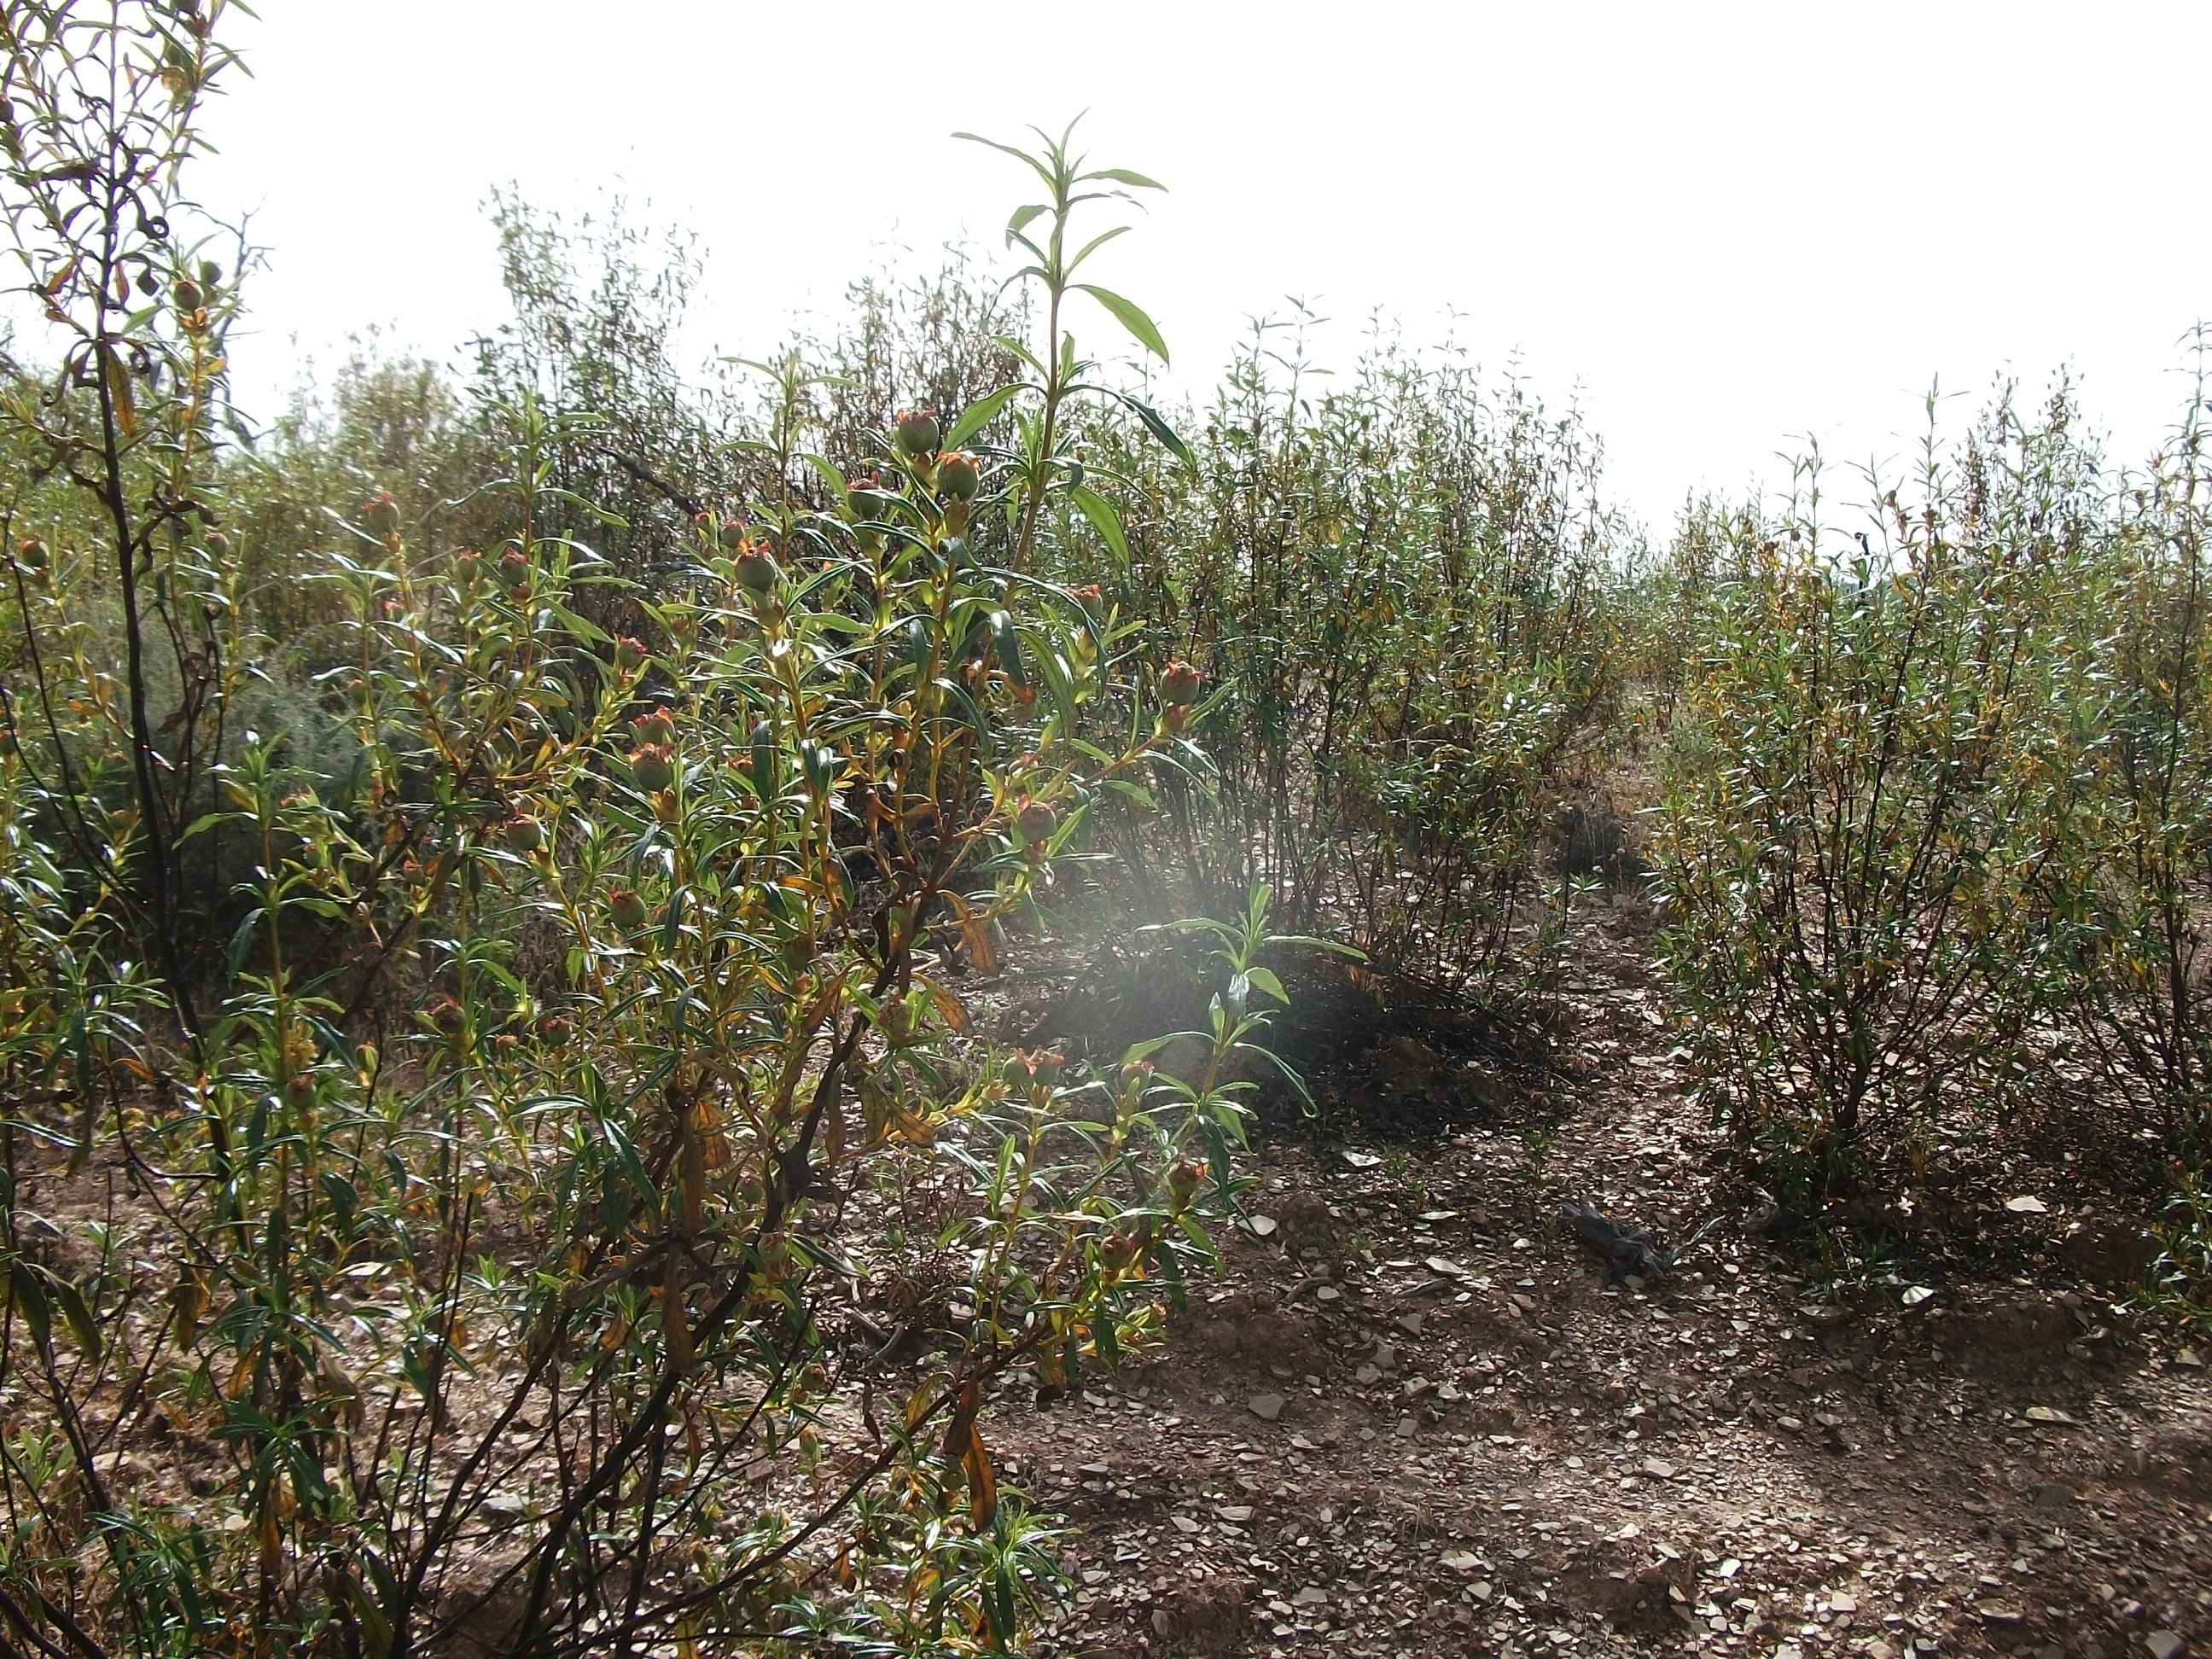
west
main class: Woodland
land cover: Broadleaved woodland
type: broadleaved evergreen forest
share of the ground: 10 - 25 %
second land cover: Spontaneously vegetated surfaces
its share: > 75 %
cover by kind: shrubs 90 %, broadleaved forest trees 10 %
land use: Agriculture (excluding fallow land and kitchen gardens)
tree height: > 5 m
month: May
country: ES
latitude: 37.6826
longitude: -6.9999
